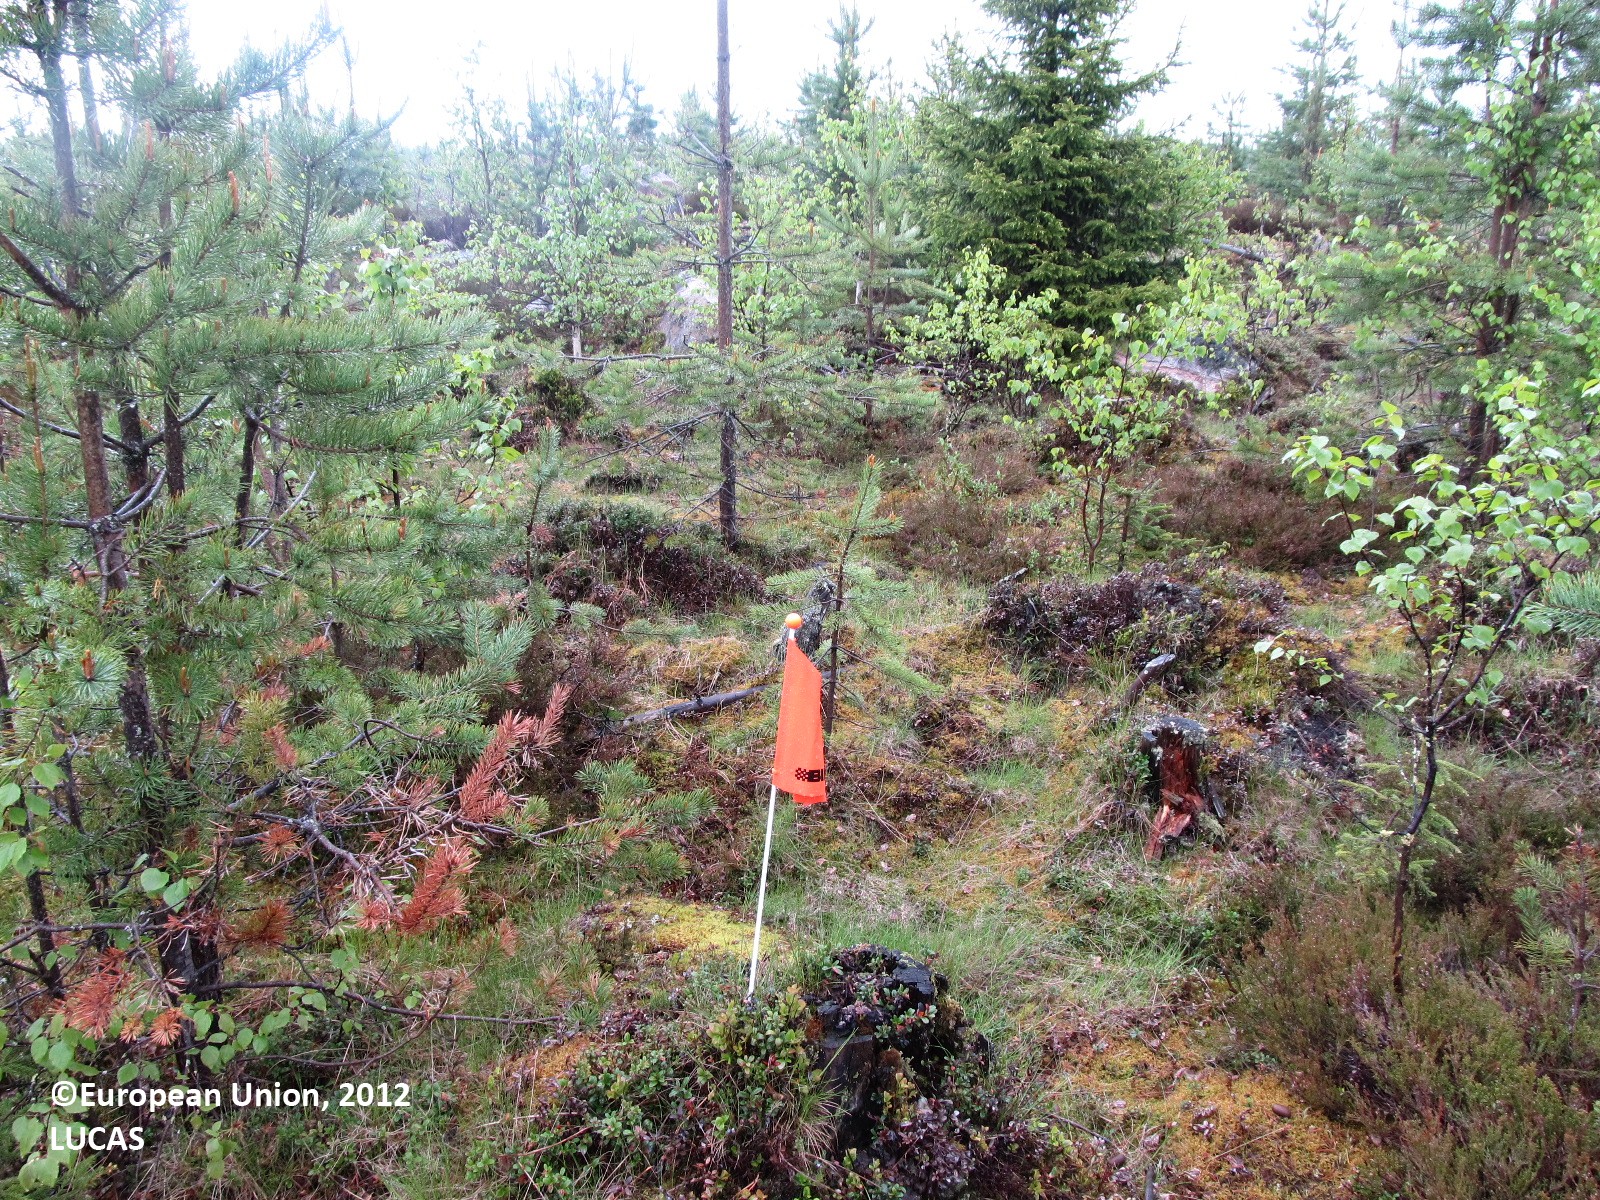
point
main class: Woodland
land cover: Pine dominated mixed woodland
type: boreal forest
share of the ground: 10 - 25 %
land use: Forestry
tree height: < 5 m
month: June
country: FI
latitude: 63.3102
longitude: 28.8220
